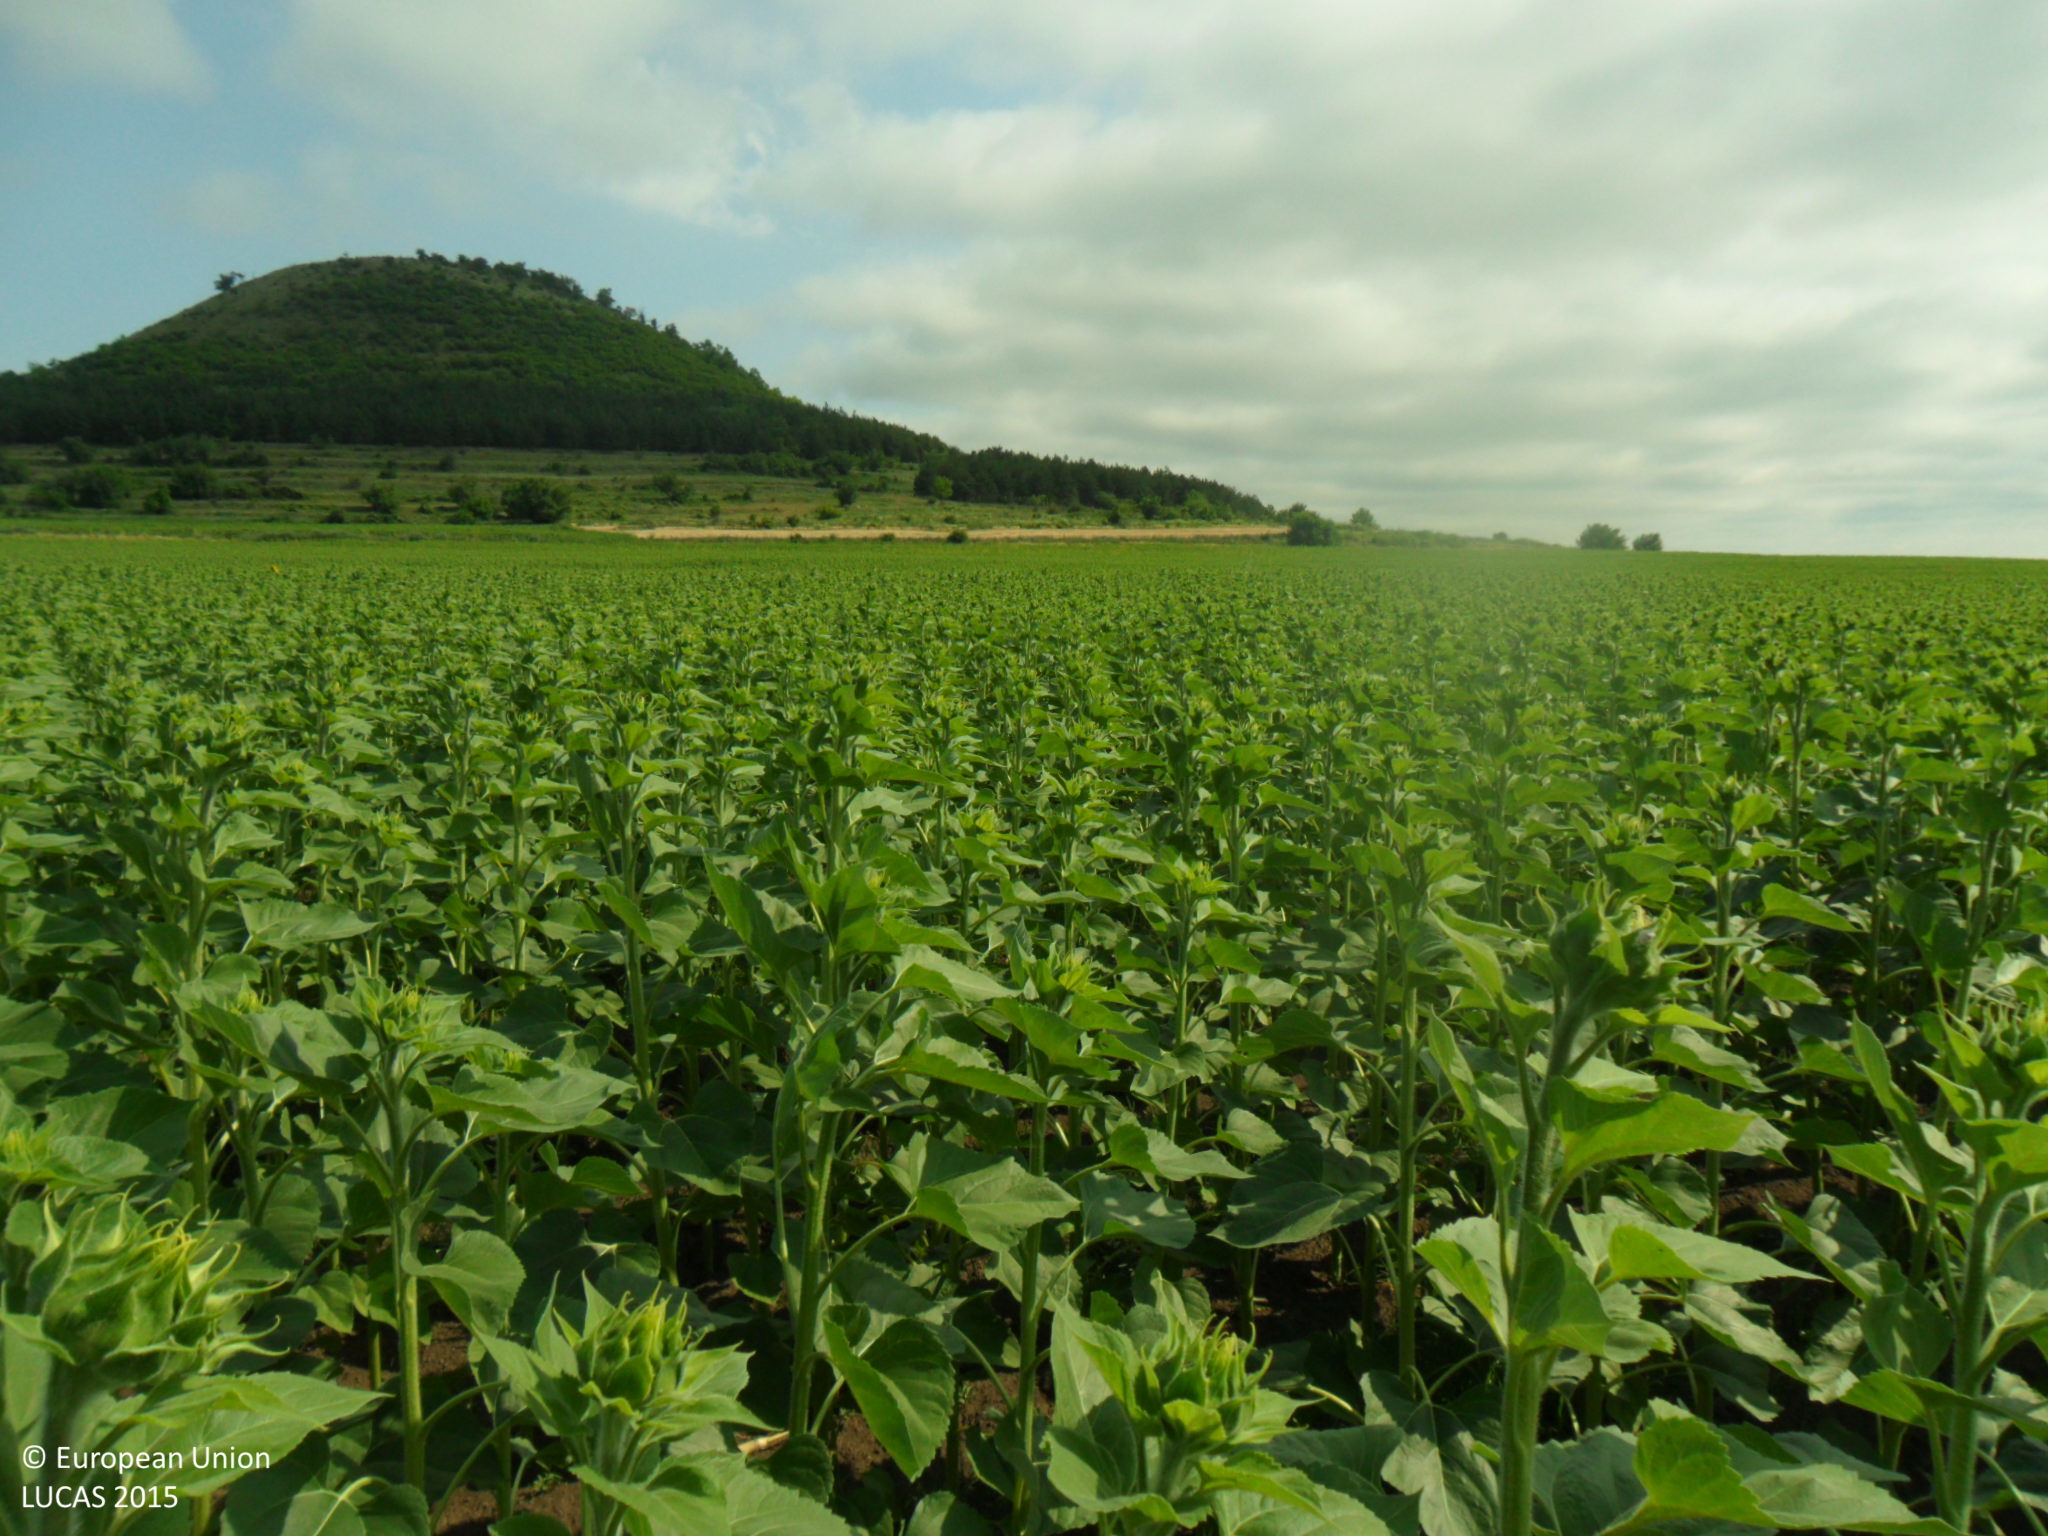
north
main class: Cropland
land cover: Sunflower
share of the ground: > 75 %
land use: Agriculture (excluding fallow land and kitchen gardens)
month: June
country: BG
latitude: 43.4461
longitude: 27.1352
